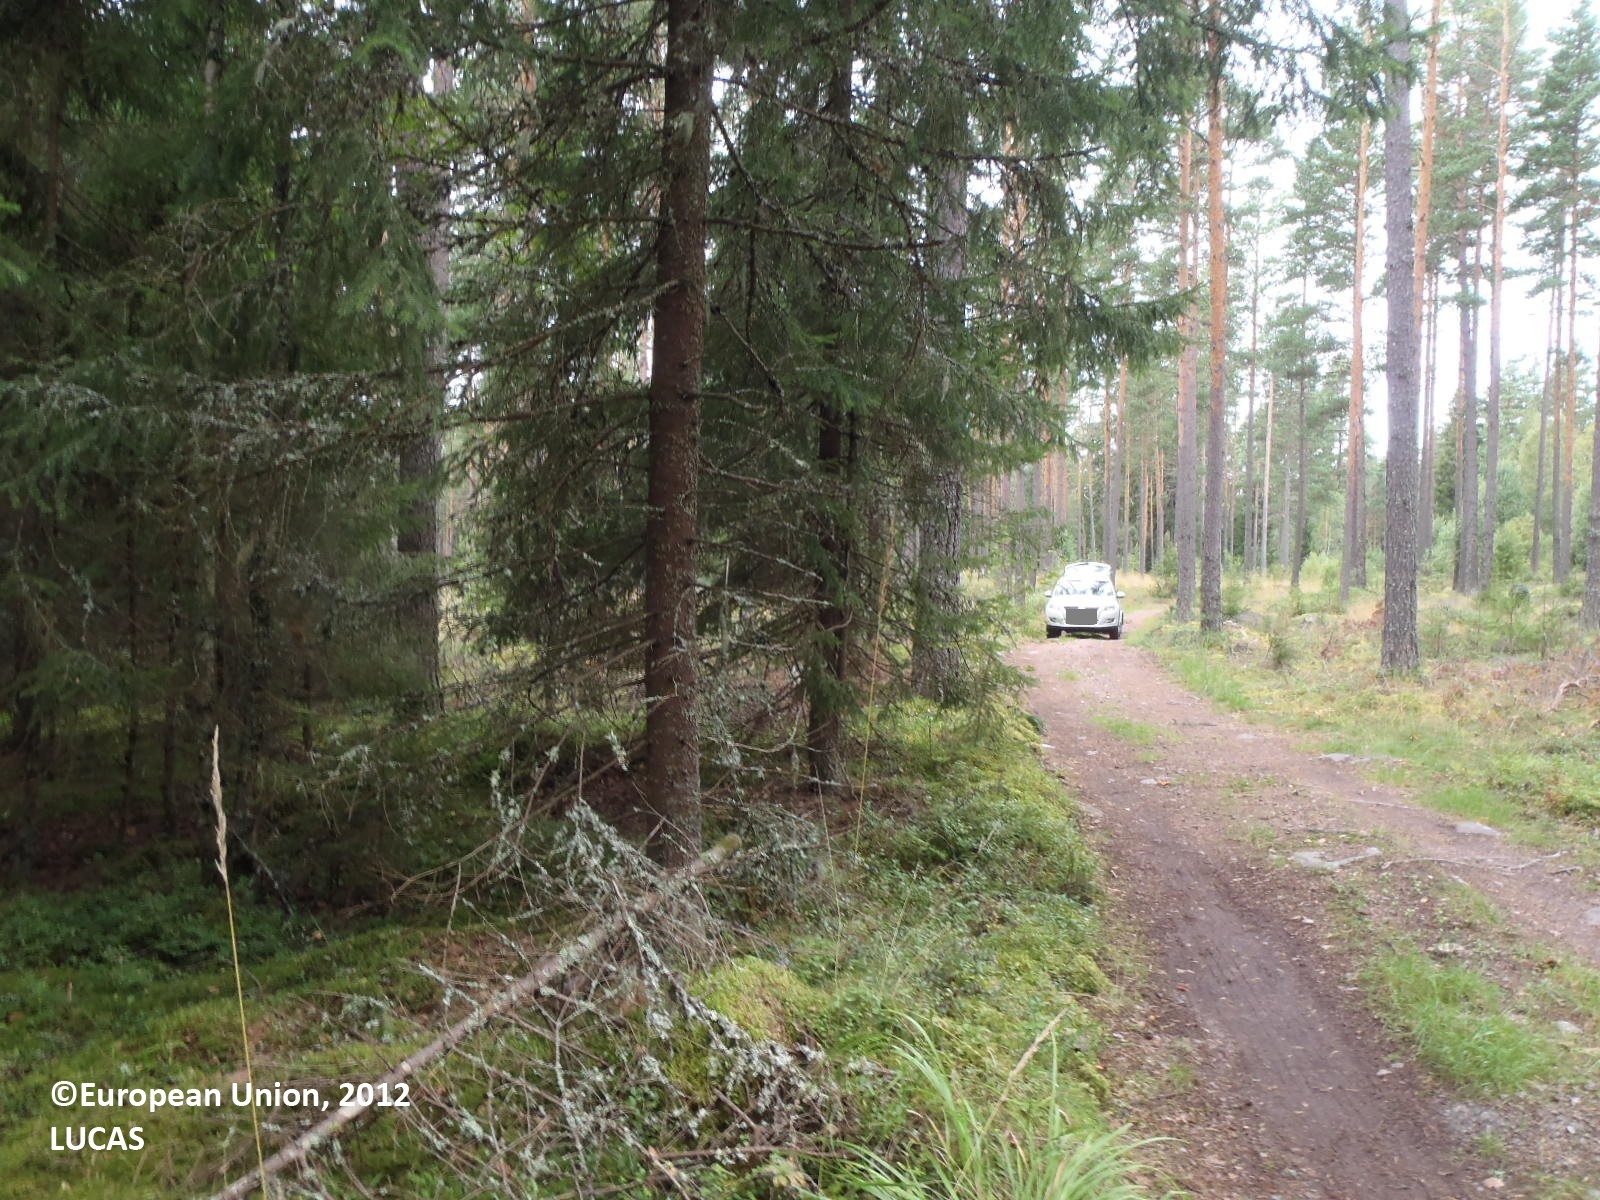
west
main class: Woodland
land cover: Pine dominated coniferous woodland
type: boreal forest
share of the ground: > 75 %
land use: Forestry
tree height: > 5 m
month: August
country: FI
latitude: 60.9051
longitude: 21.8017
